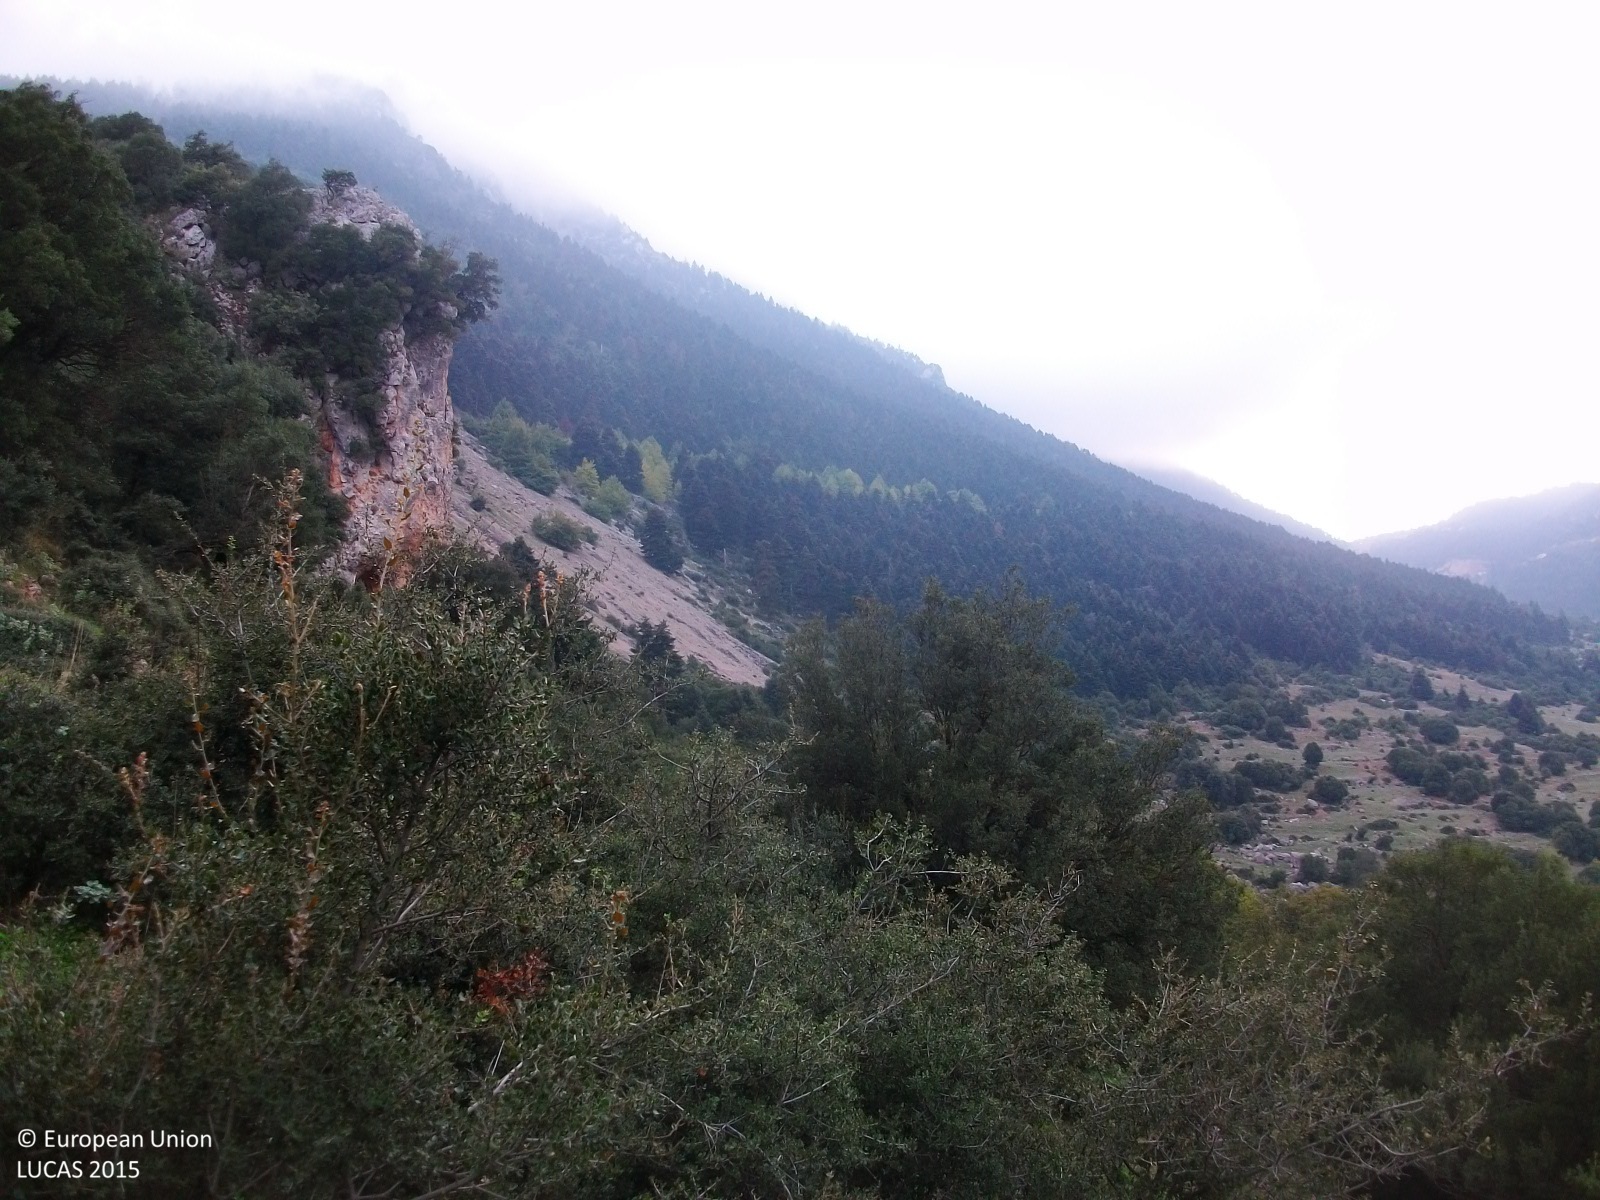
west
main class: Shrubland
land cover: Shrubland with sparse tree cover
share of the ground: 50 - 75 %
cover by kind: shrubs 50 %, herbaceous plants 40 %, broadleaved forest trees 5 %, unconsolidated bare surface 5 %
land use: Semi-natural and natural areas not in use
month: October
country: GR
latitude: 37.8502
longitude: 22.3884
